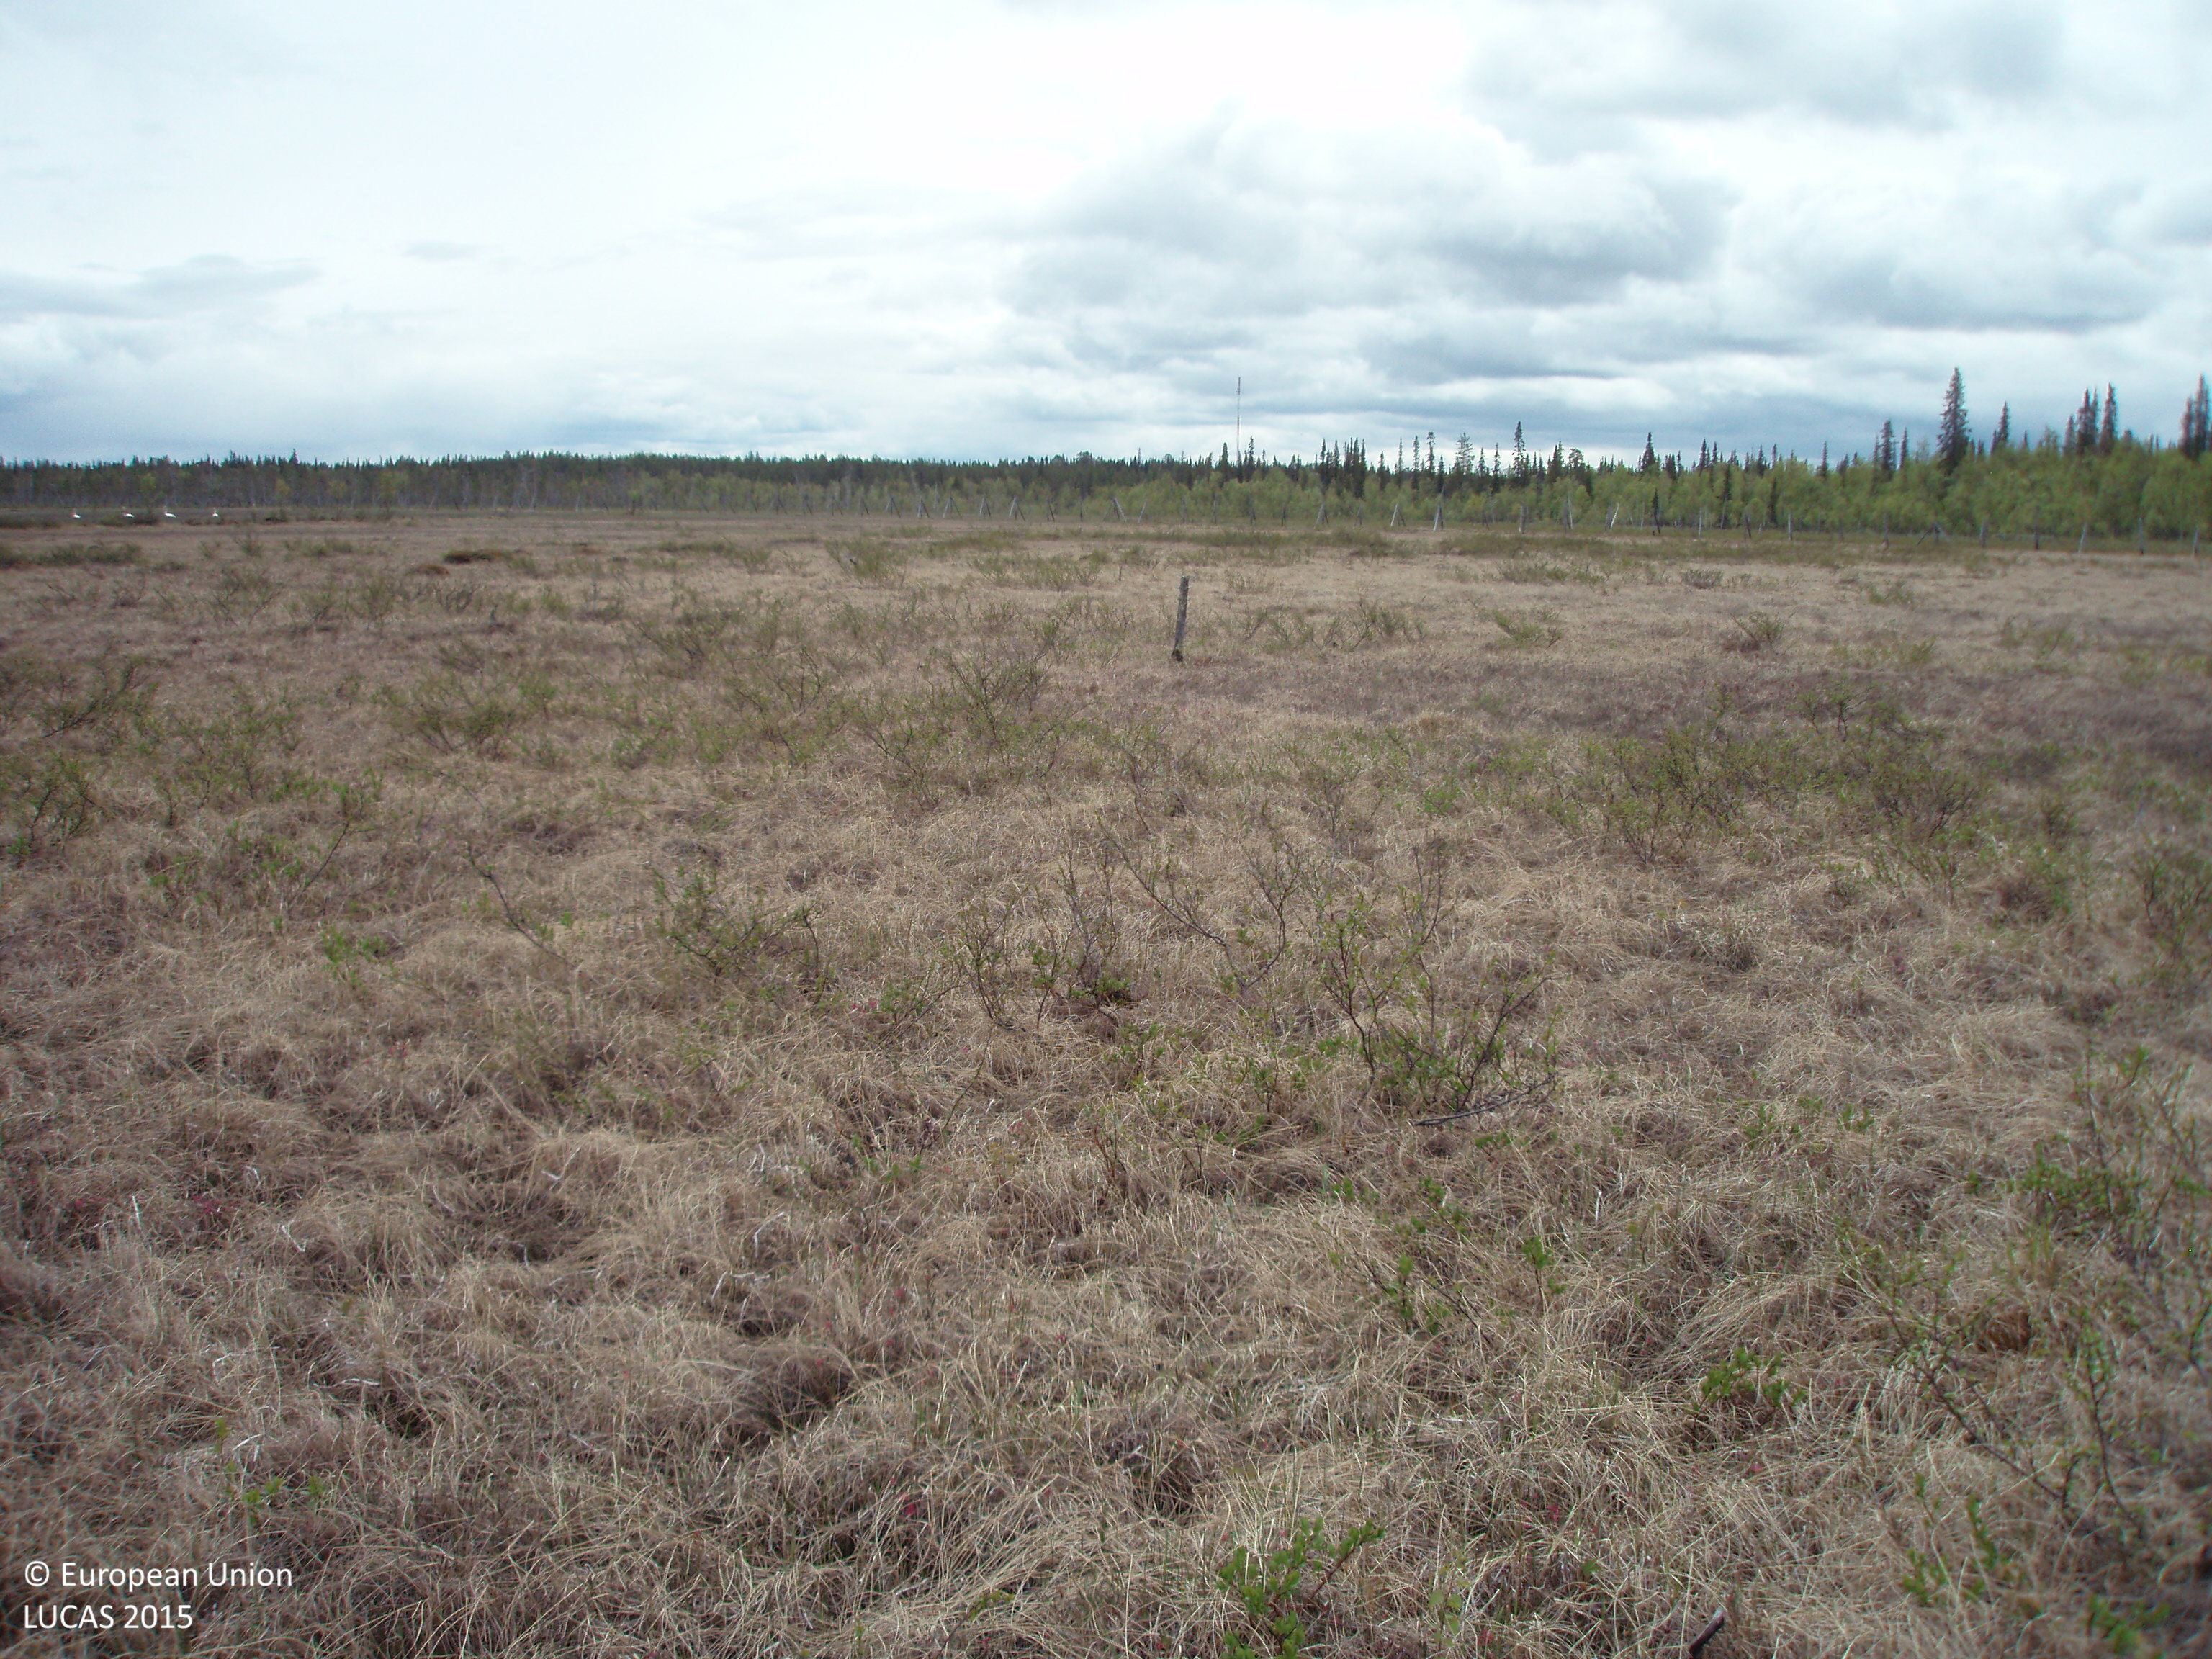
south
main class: Shrubland
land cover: Shrubland without tree cover
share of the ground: > 75 %
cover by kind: shrubs 60 %, herbaceous plants 40 %
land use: Semi-natural and natural areas not in use
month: June
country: FI
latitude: 67.9625
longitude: 26.7637
